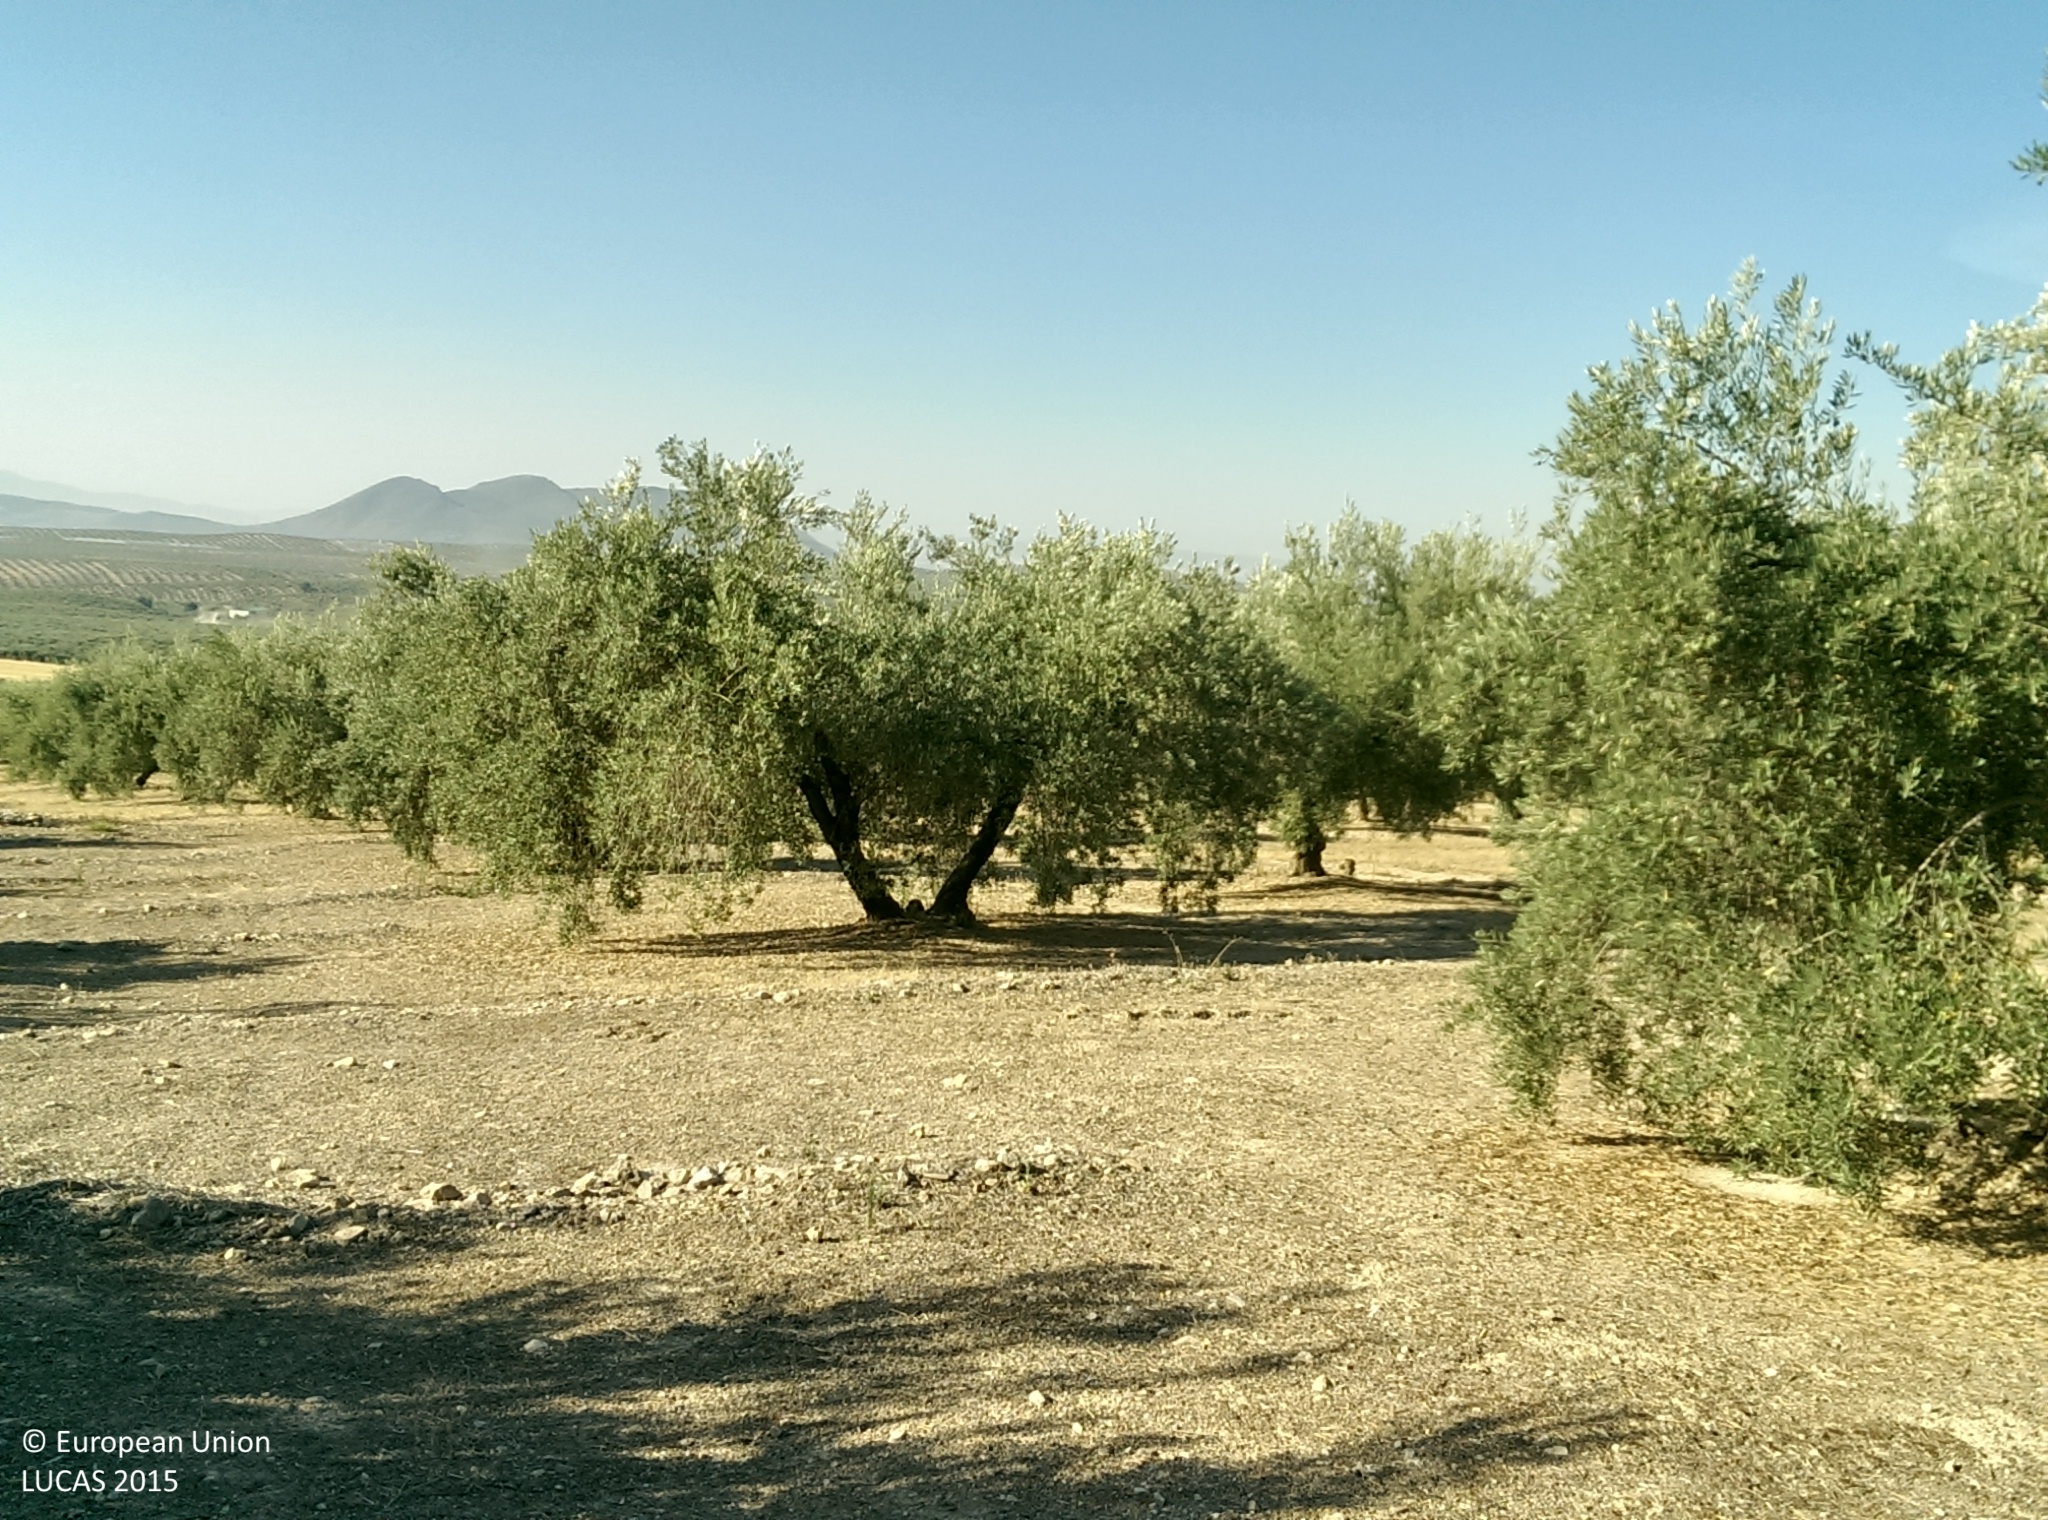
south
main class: Cropland
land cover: Olive groves
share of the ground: 25 - 50 %
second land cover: Other bare soil
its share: > 75 %
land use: Agriculture (excluding fallow land and kitchen gardens)
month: July
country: ES
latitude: 37.3344
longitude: -3.7289
